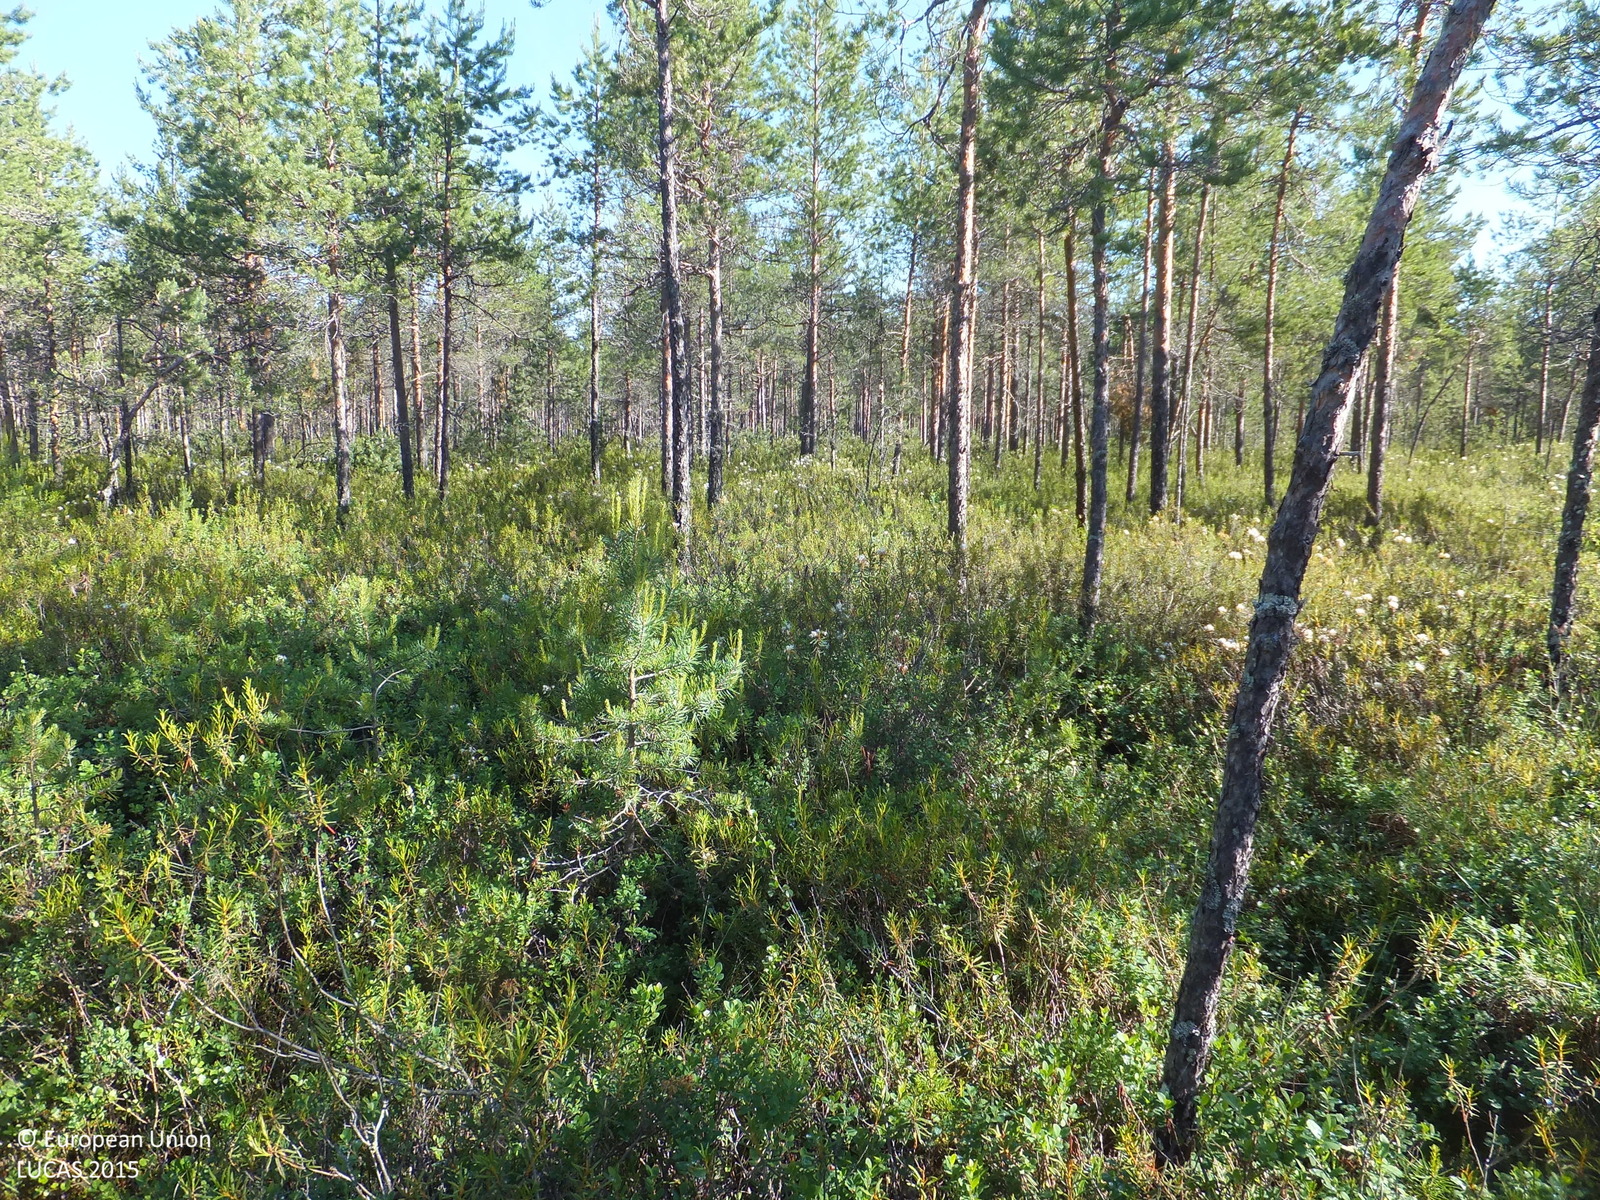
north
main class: Woodland
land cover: Pine dominated coniferous woodland
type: mire and swamp forests
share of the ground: 50 - 75 %
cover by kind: coniferous forest trees 50 %, shrubs 40 %, lichens and mosses 10 %
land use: Forestry
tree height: > 5 m
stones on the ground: < 10 %
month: July
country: FI
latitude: 63.1708
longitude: 23.9548
